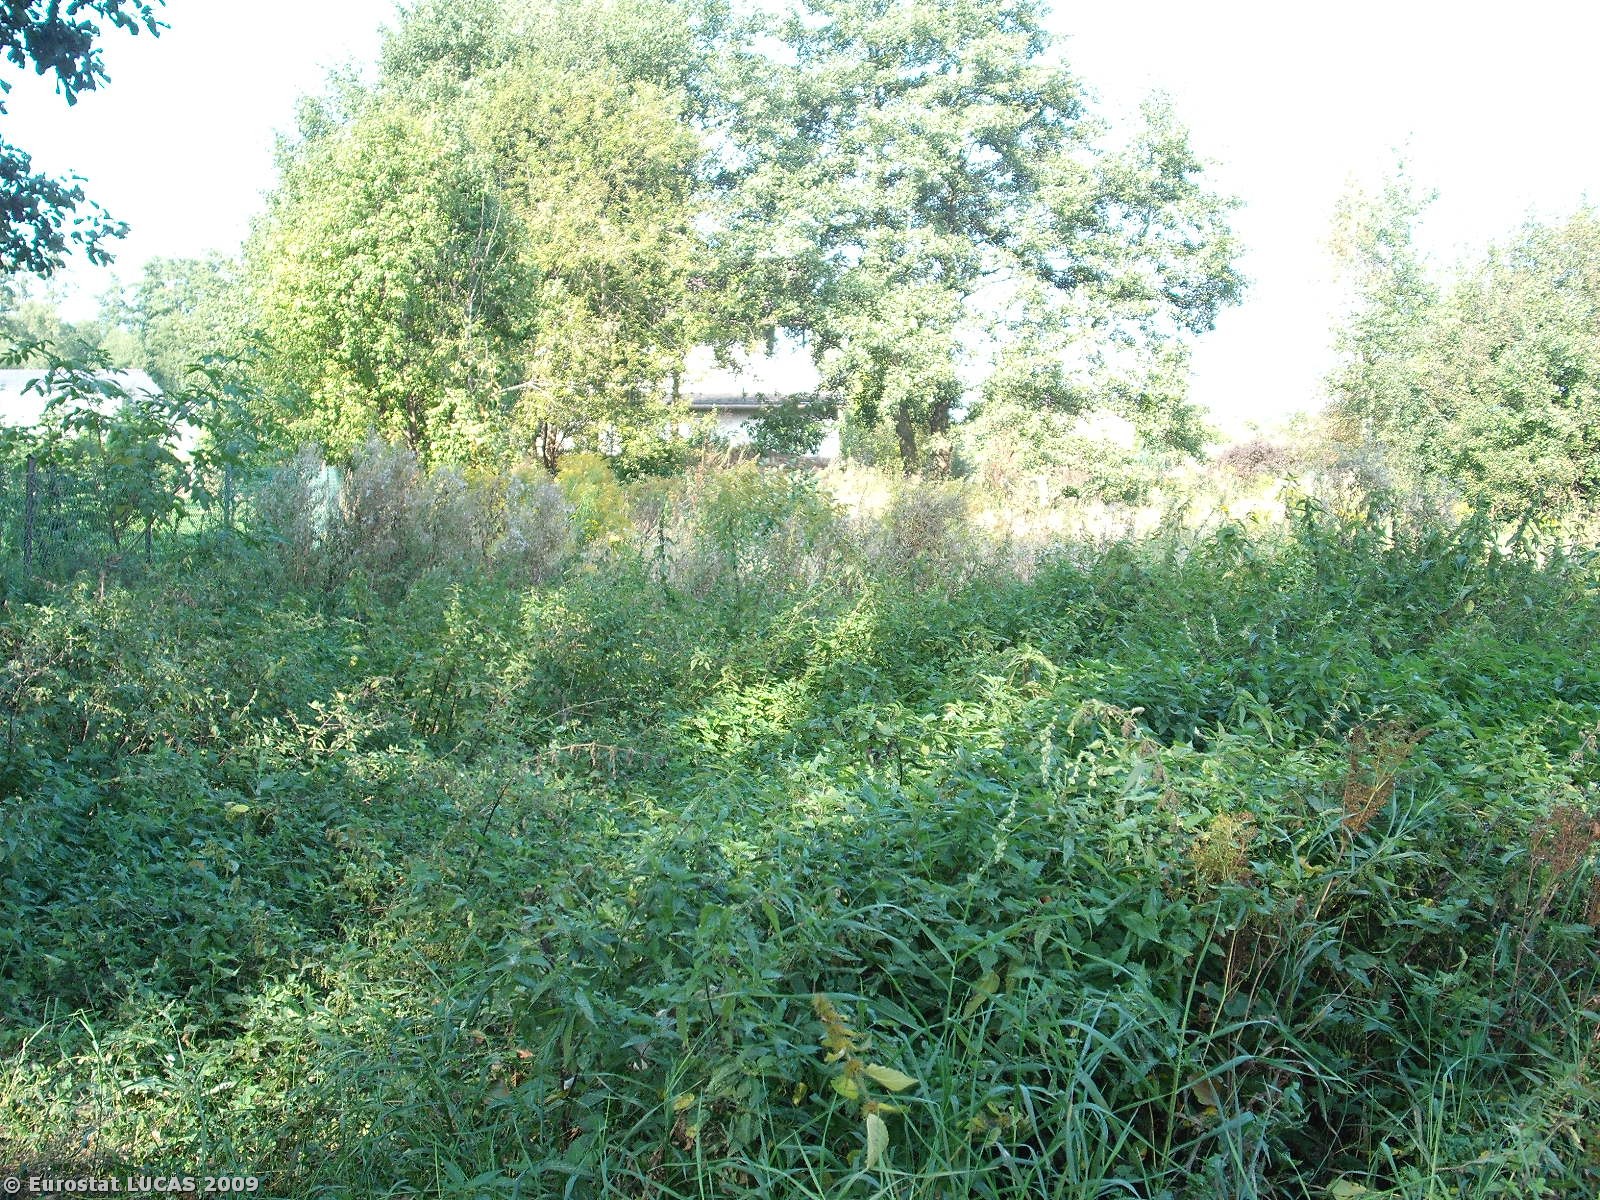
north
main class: Grassland
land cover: Spontaneously vegetated surfaces
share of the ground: > 75 %
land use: Unused
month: September
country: PL
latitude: 52.0351
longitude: 20.7261
